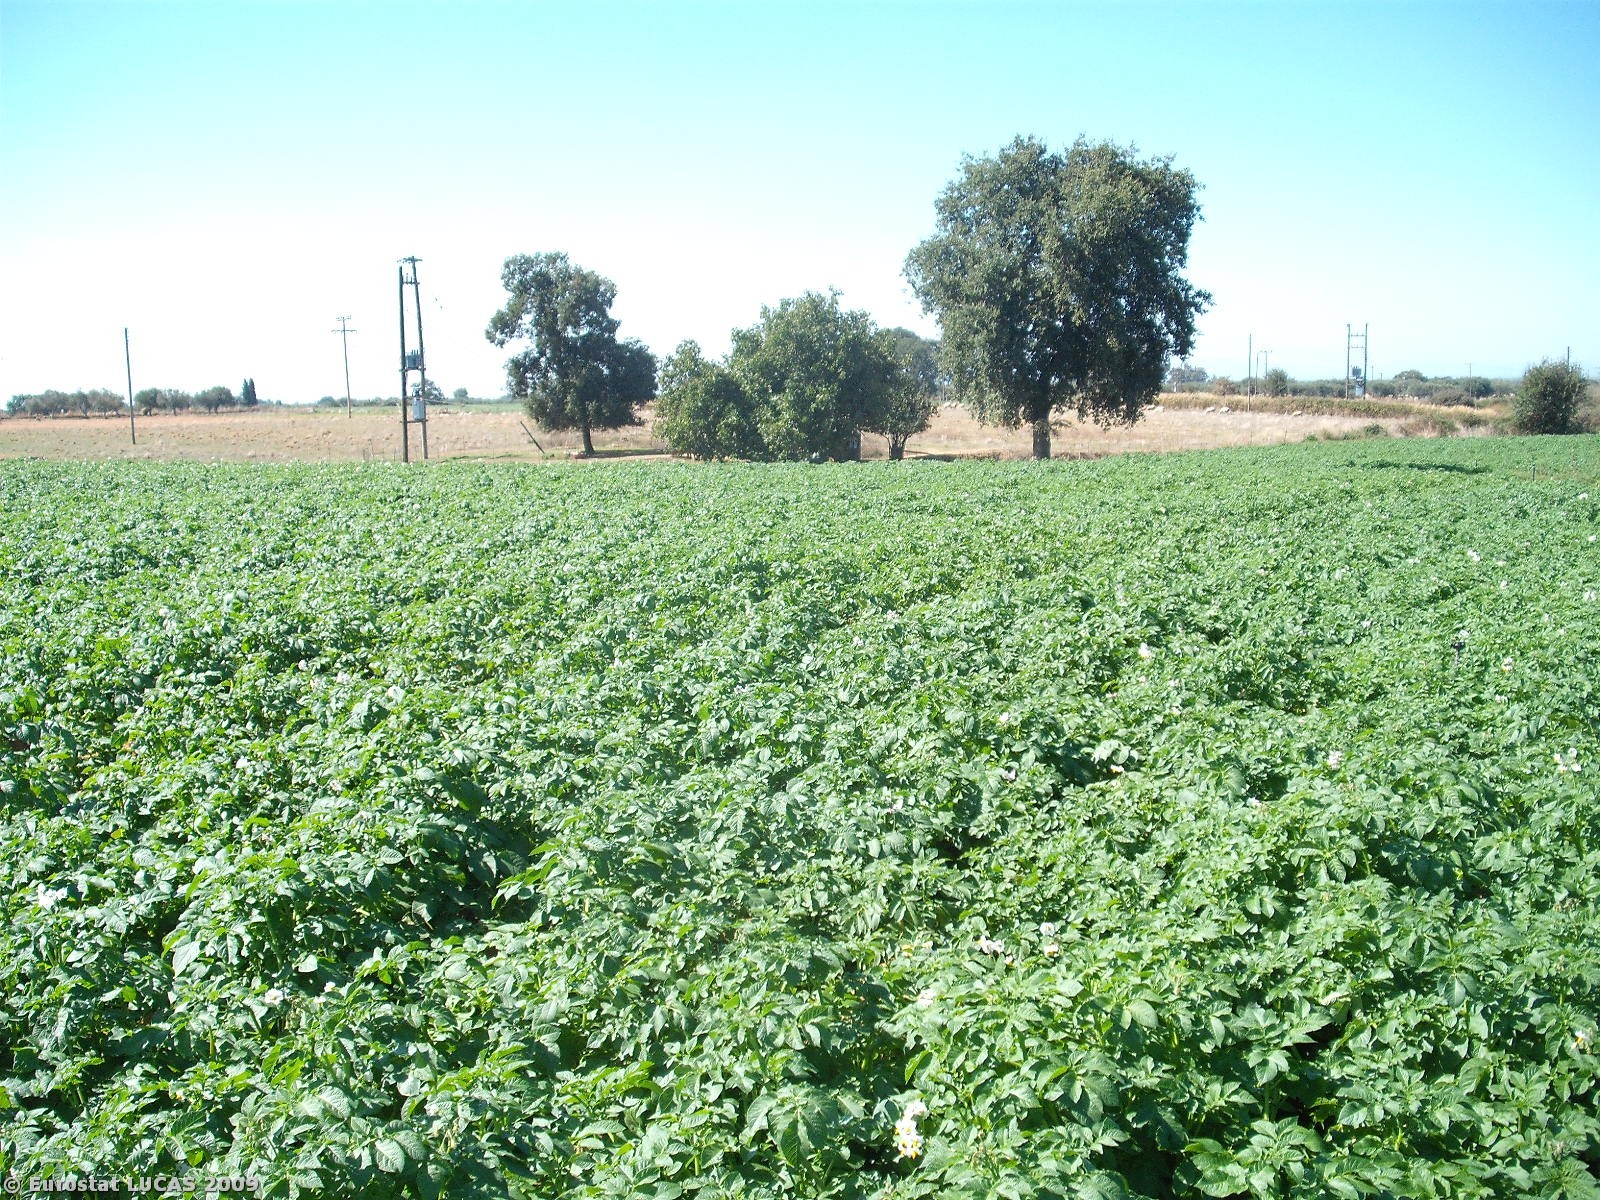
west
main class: Cropland
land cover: Potatoes
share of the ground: > 75 %
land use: Agriculture (excluding fallow land and kitchen gardens)
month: October
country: GR
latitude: 38.0430
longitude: 21.4376
